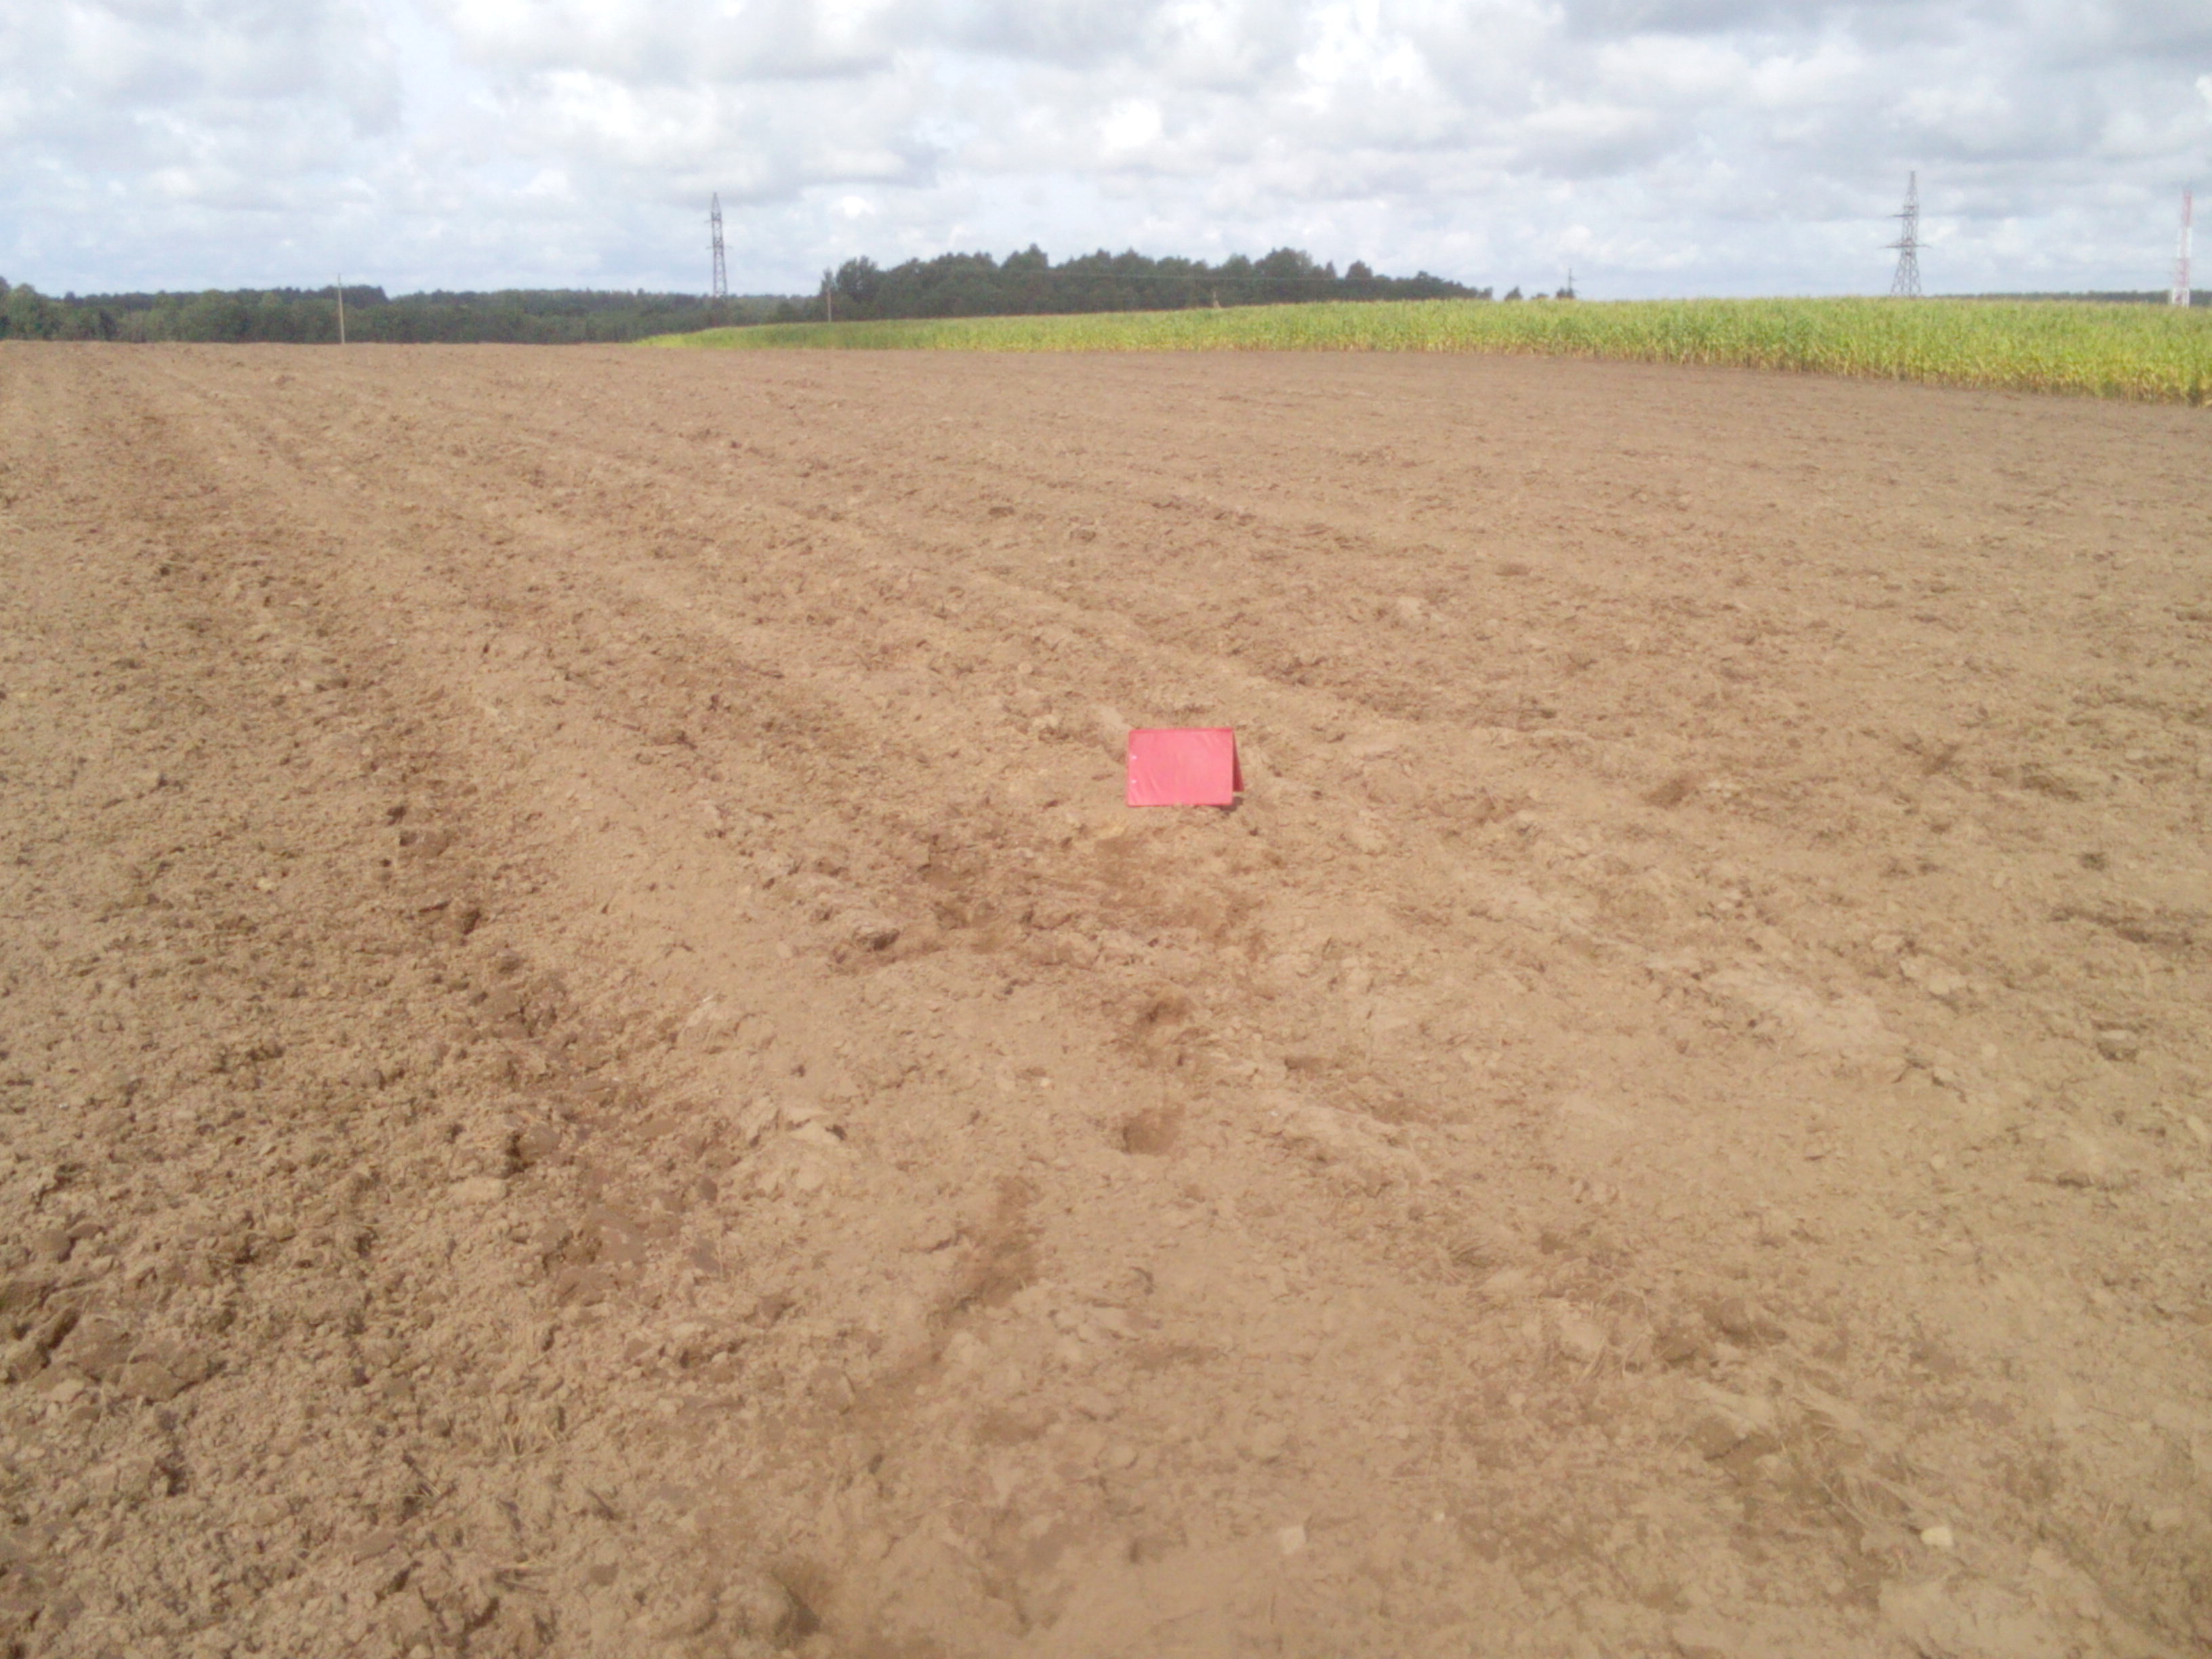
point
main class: Cropland
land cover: Common wheat
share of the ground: < 10 %
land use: Agriculture (excluding fallow land and kitchen gardens)
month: September
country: LT
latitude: 55.9027
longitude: 22.4871
